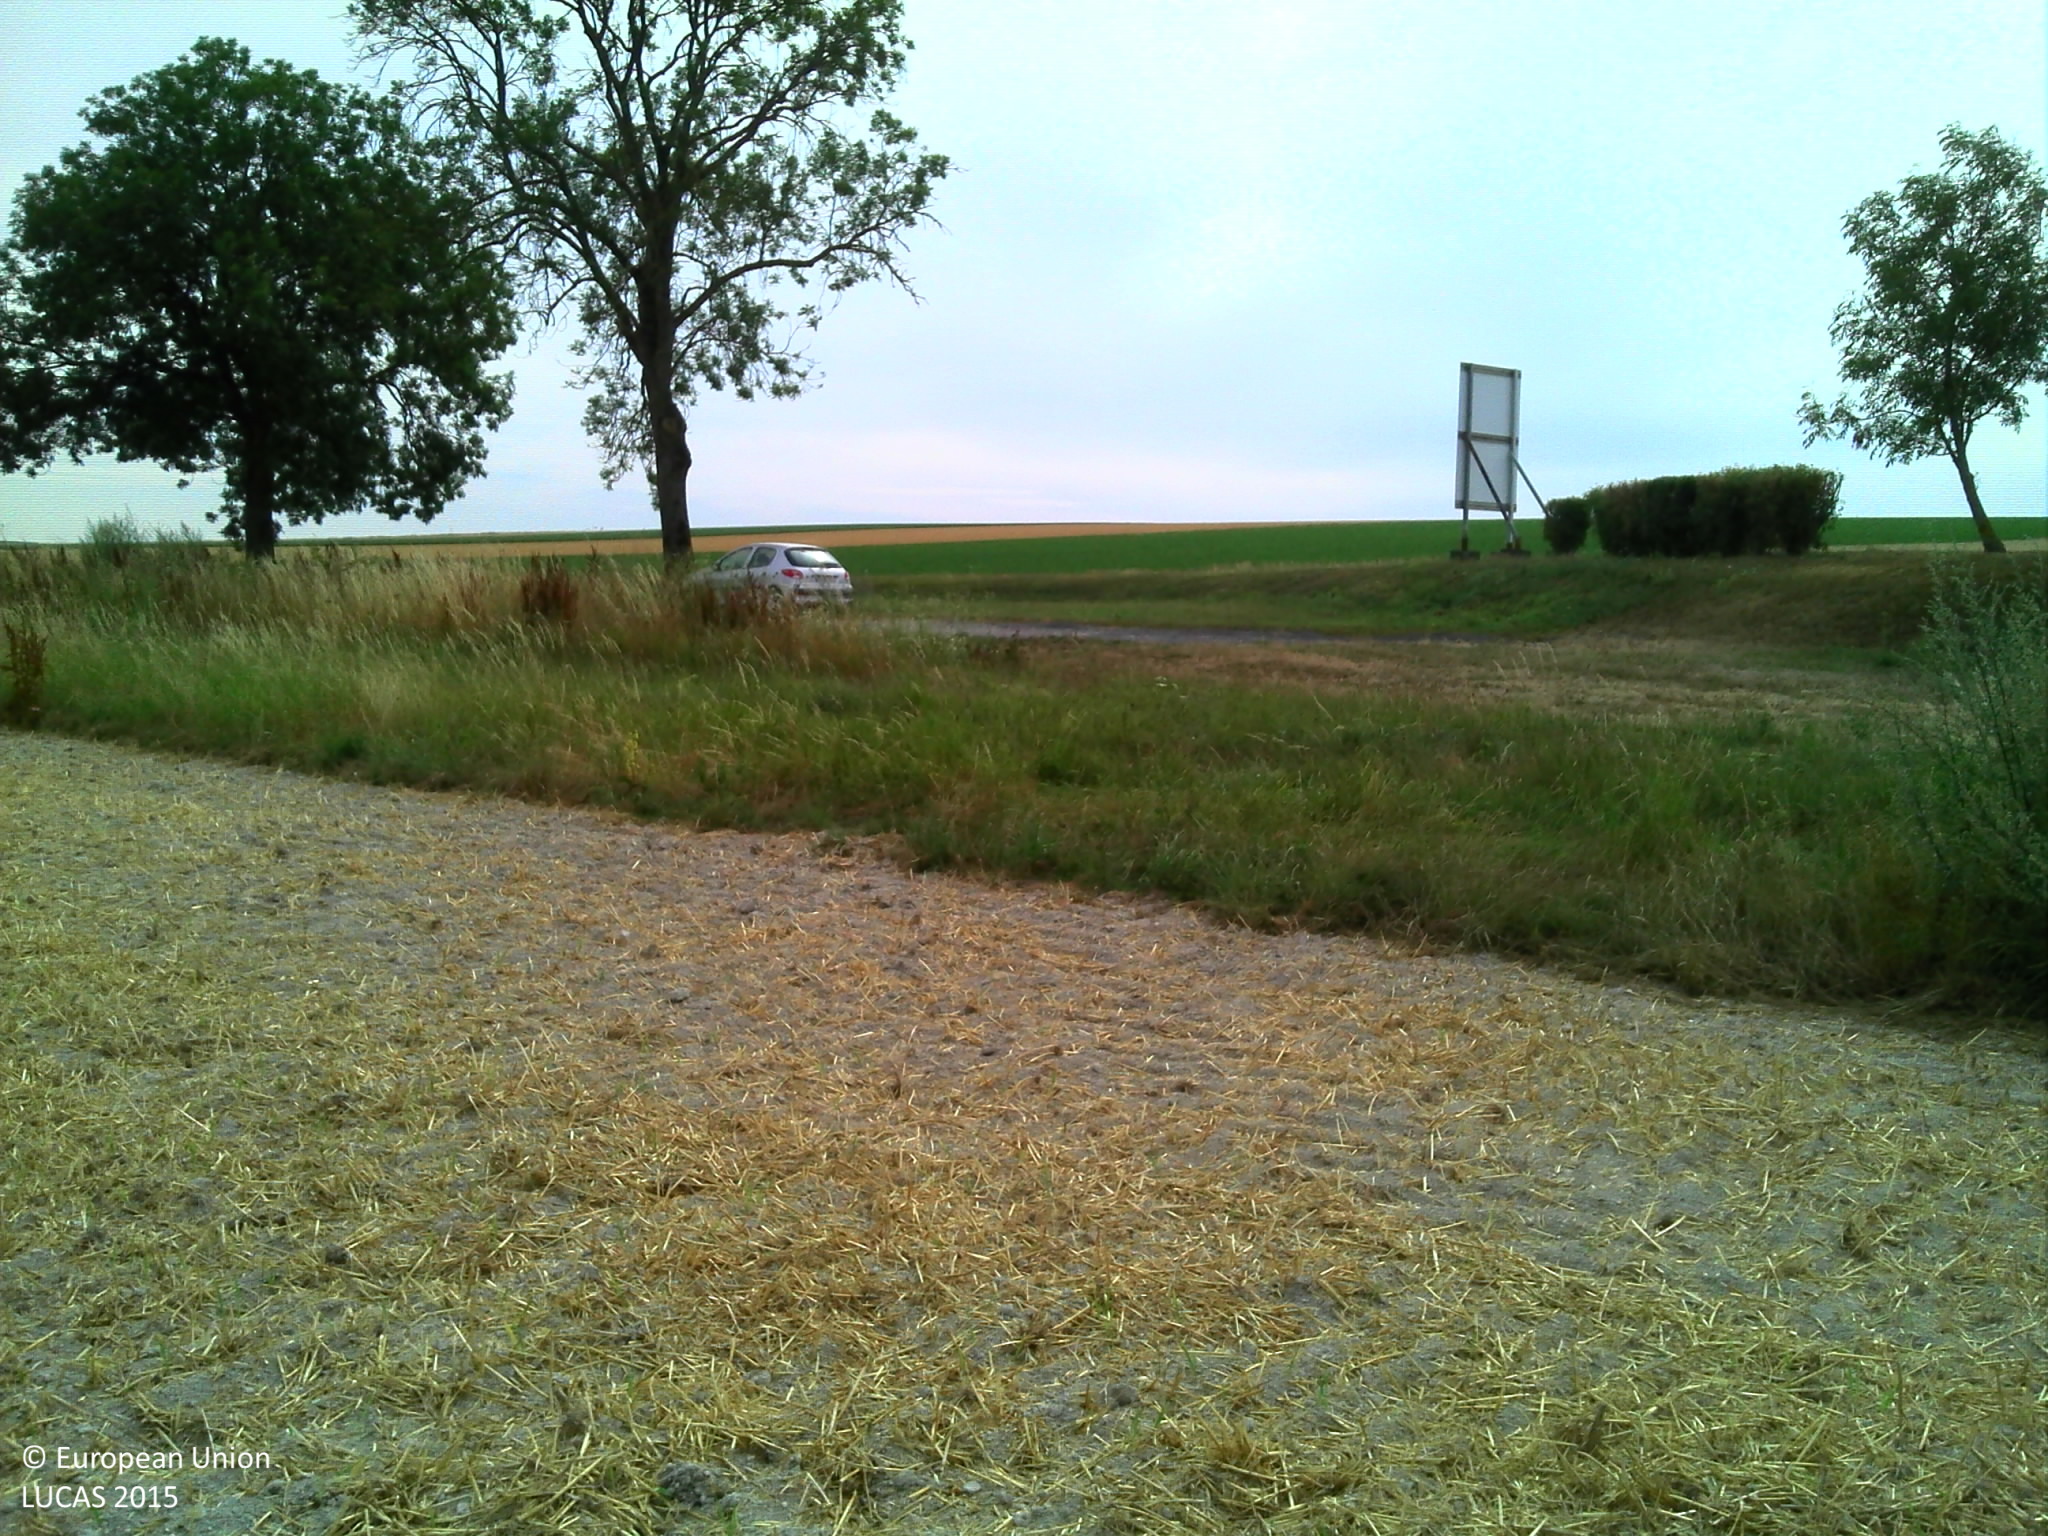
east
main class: Cropland
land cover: Barley
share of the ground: > 75 %
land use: Agriculture (excluding fallow land and kitchen gardens)
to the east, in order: Barley; Grassland without tree/shrub cover; Tracks; Lines of trees; Paved roads, cycling and walking lanes; Grassland without tree/shrub cover; Tracks; Grass margins; Ditches and canals; Grass margins; Sugar beet
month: July
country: FR
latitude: 48.8439
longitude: 4.1501
